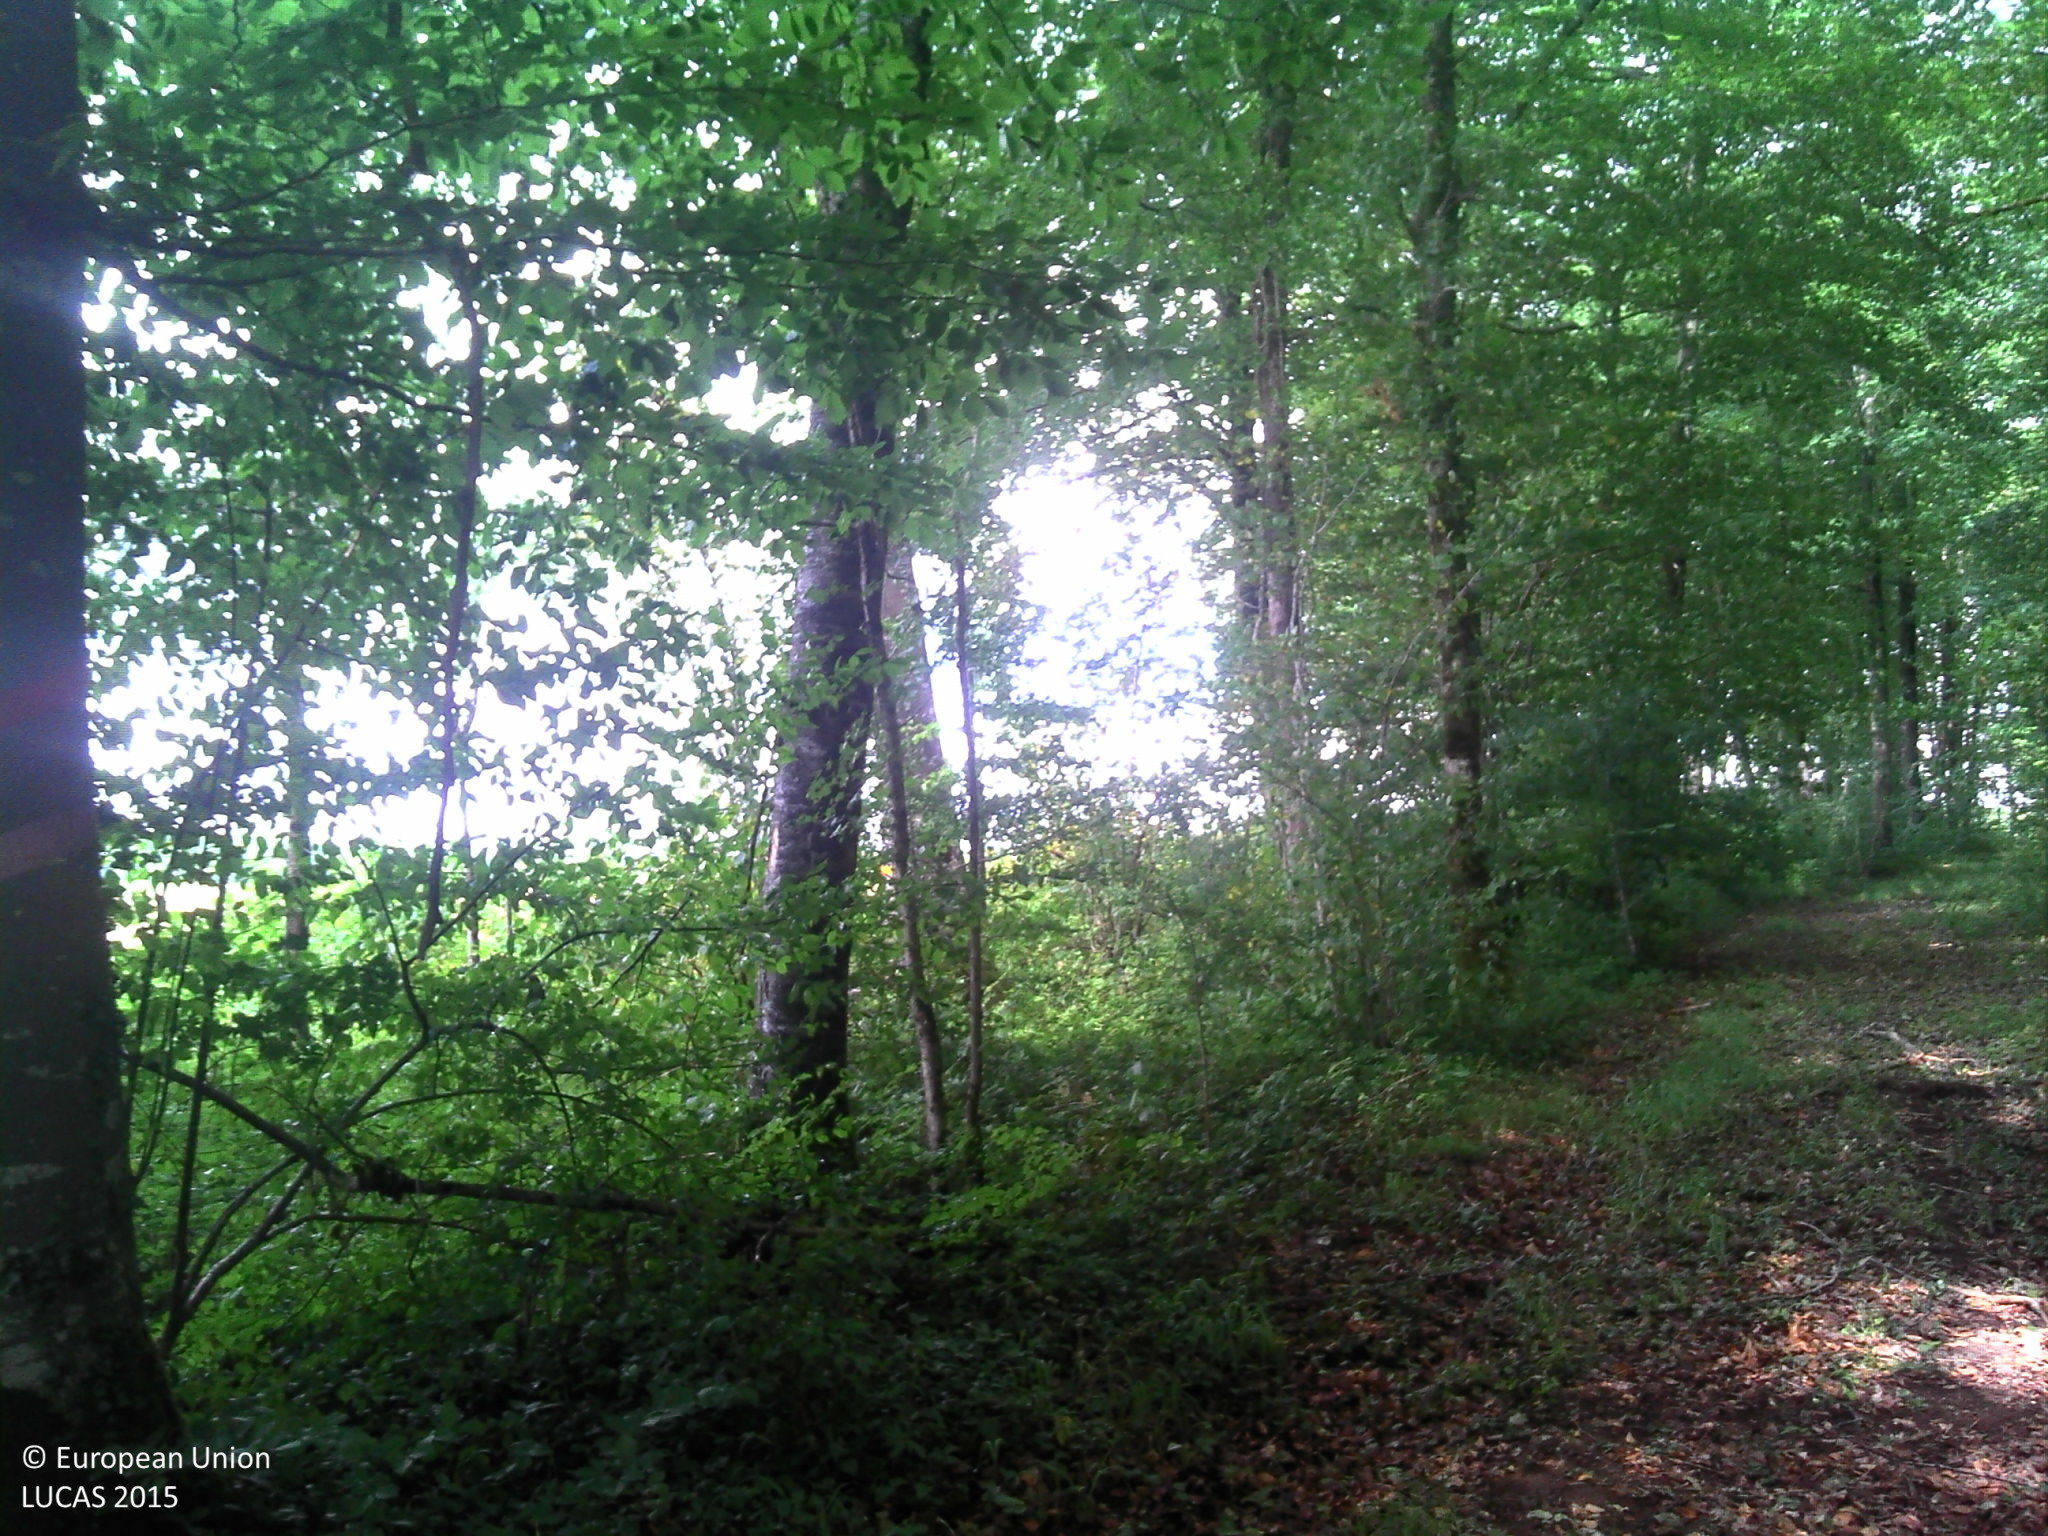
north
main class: Woodland
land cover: Broadleaved woodland
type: mesophytic deciduous forest
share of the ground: > 75 %
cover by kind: broadleaved forest trees 75 %, herbaceous plants 20 %, lichens and mosses 5 %
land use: Forestry
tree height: > 5 m
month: August
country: FR
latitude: 47.7327
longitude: 5.0261
